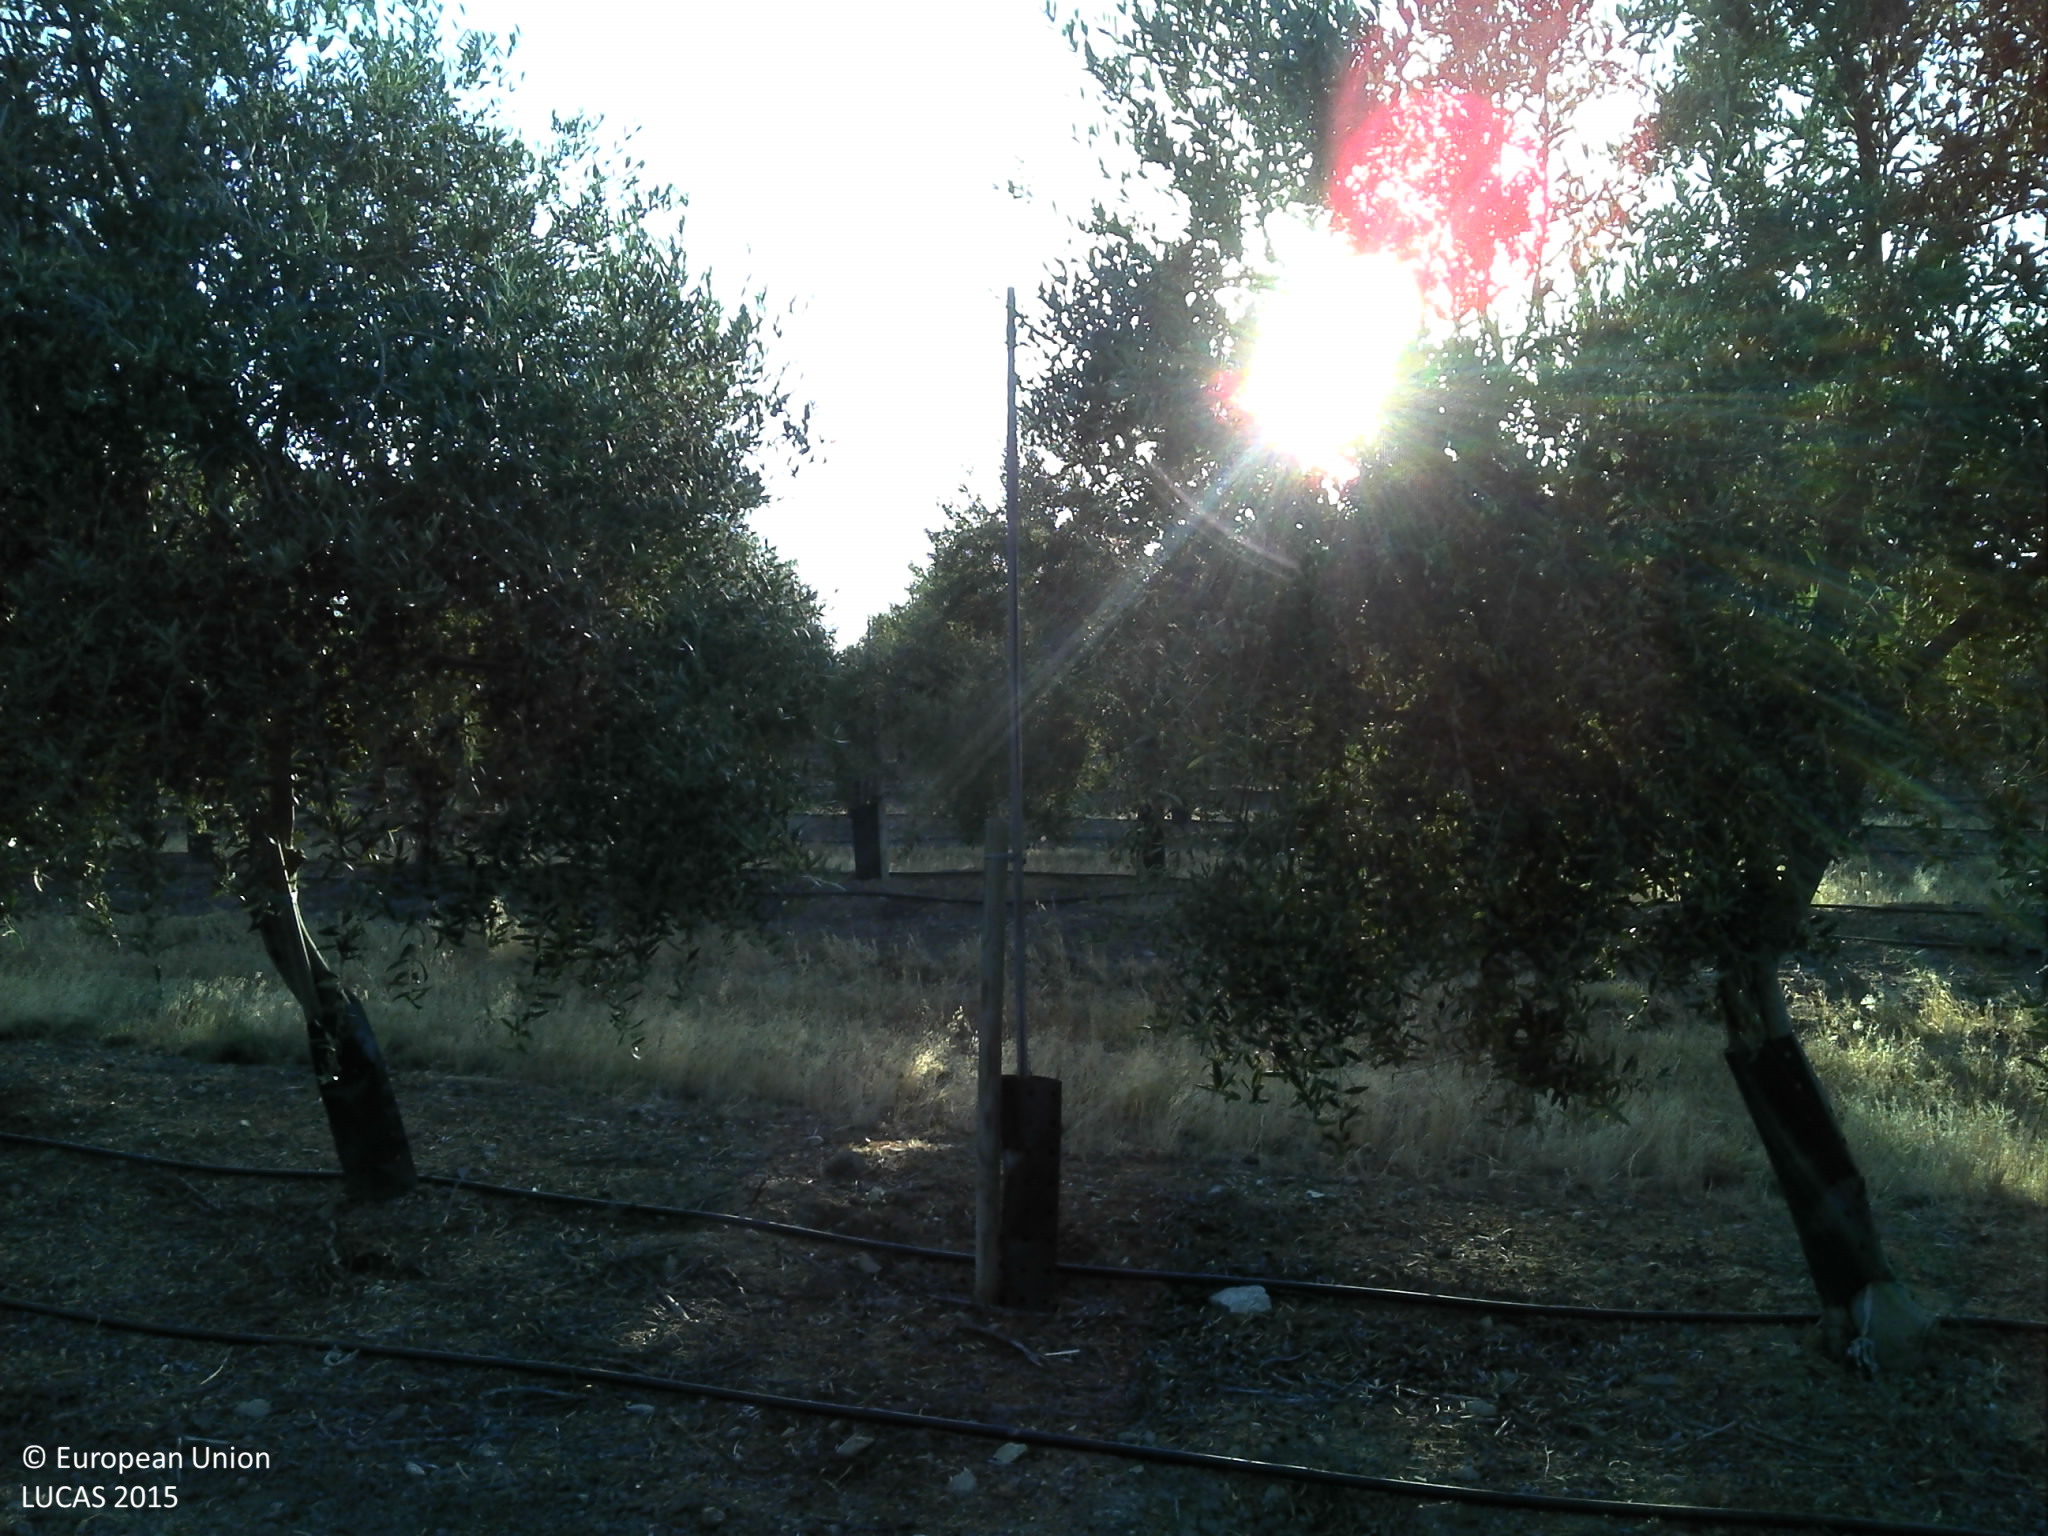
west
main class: Cropland
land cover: Olive groves
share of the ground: 25 - 50 %
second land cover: Spontaneously vegetated surfaces
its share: 10 - 25 %
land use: Agriculture (excluding fallow land and kitchen gardens)
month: June
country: PT
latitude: 38.1604
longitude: -8.1029
